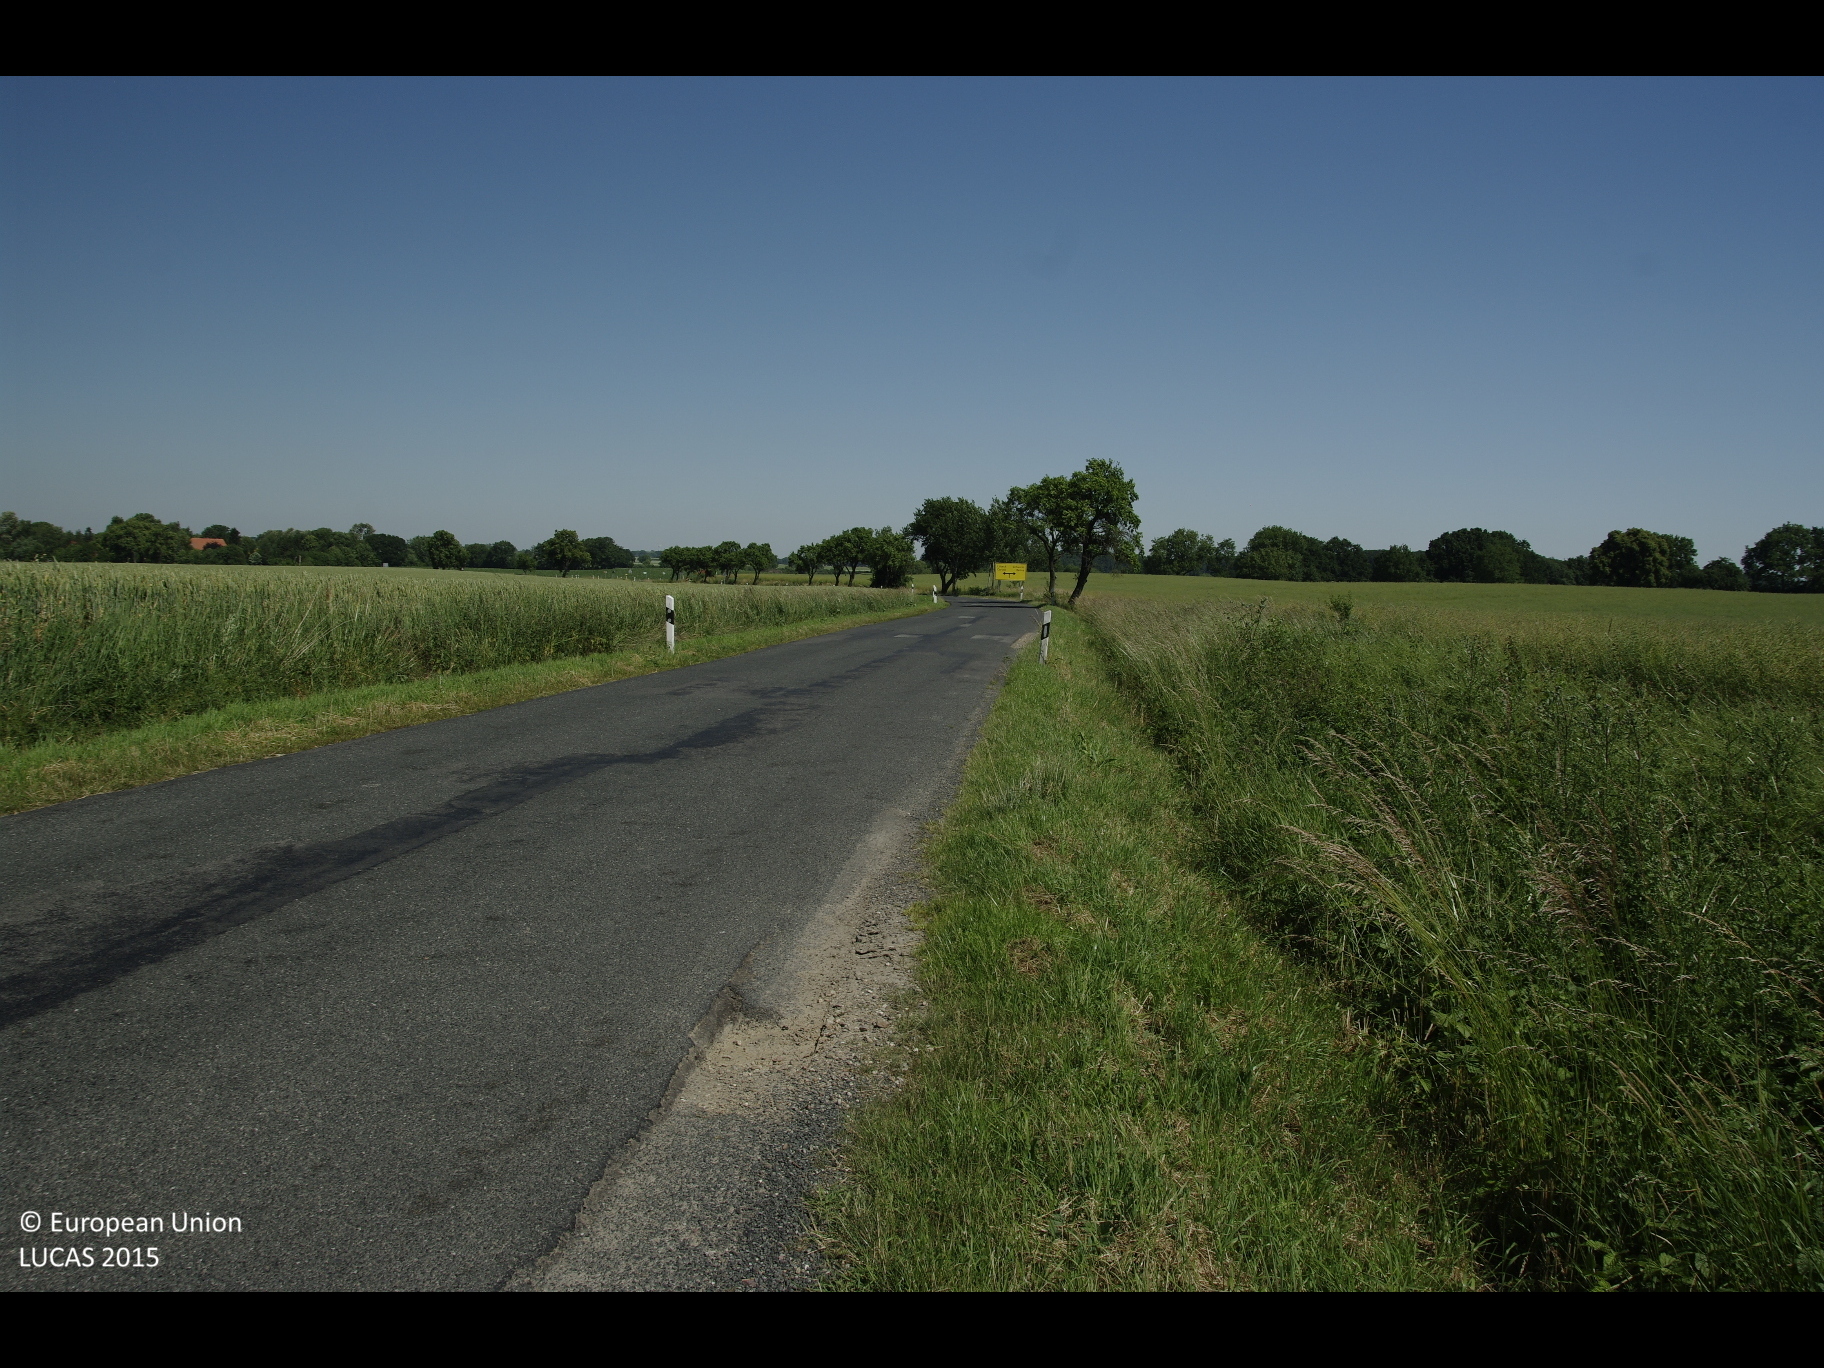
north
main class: Cropland
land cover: Rape and turnip rape
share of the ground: > 75 %
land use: Agriculture (excluding fallow land and kitchen gardens)
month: July
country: DE
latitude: 53.7574
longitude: 10.9854
